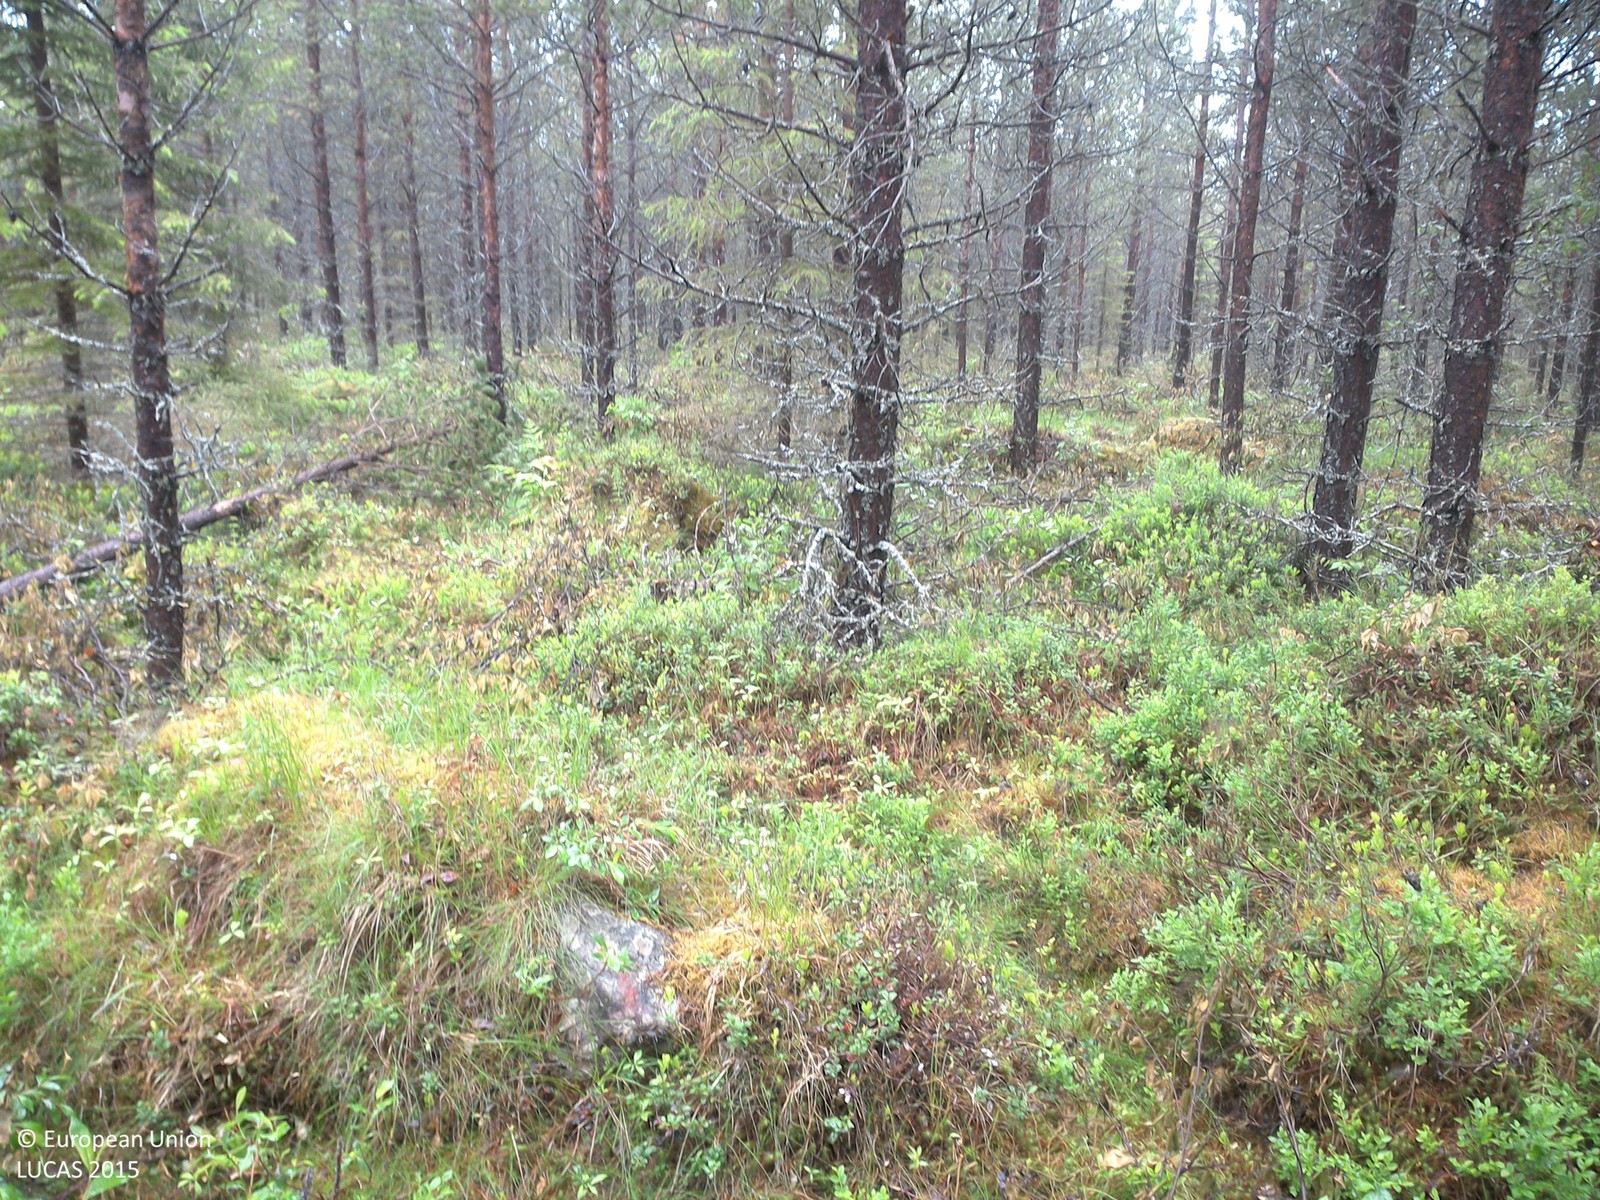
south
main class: Woodland
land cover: Pine dominated coniferous woodland
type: boreal forest
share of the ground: 25 - 50 %
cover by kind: shrubs 50 %, coniferous forest trees 40 %, herbaceous plants 5 %, lichens and mosses 5 %
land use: Forestry
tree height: > 5 m
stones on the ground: < 10 %
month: July
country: SE
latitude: 66.9756
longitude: 23.6110
